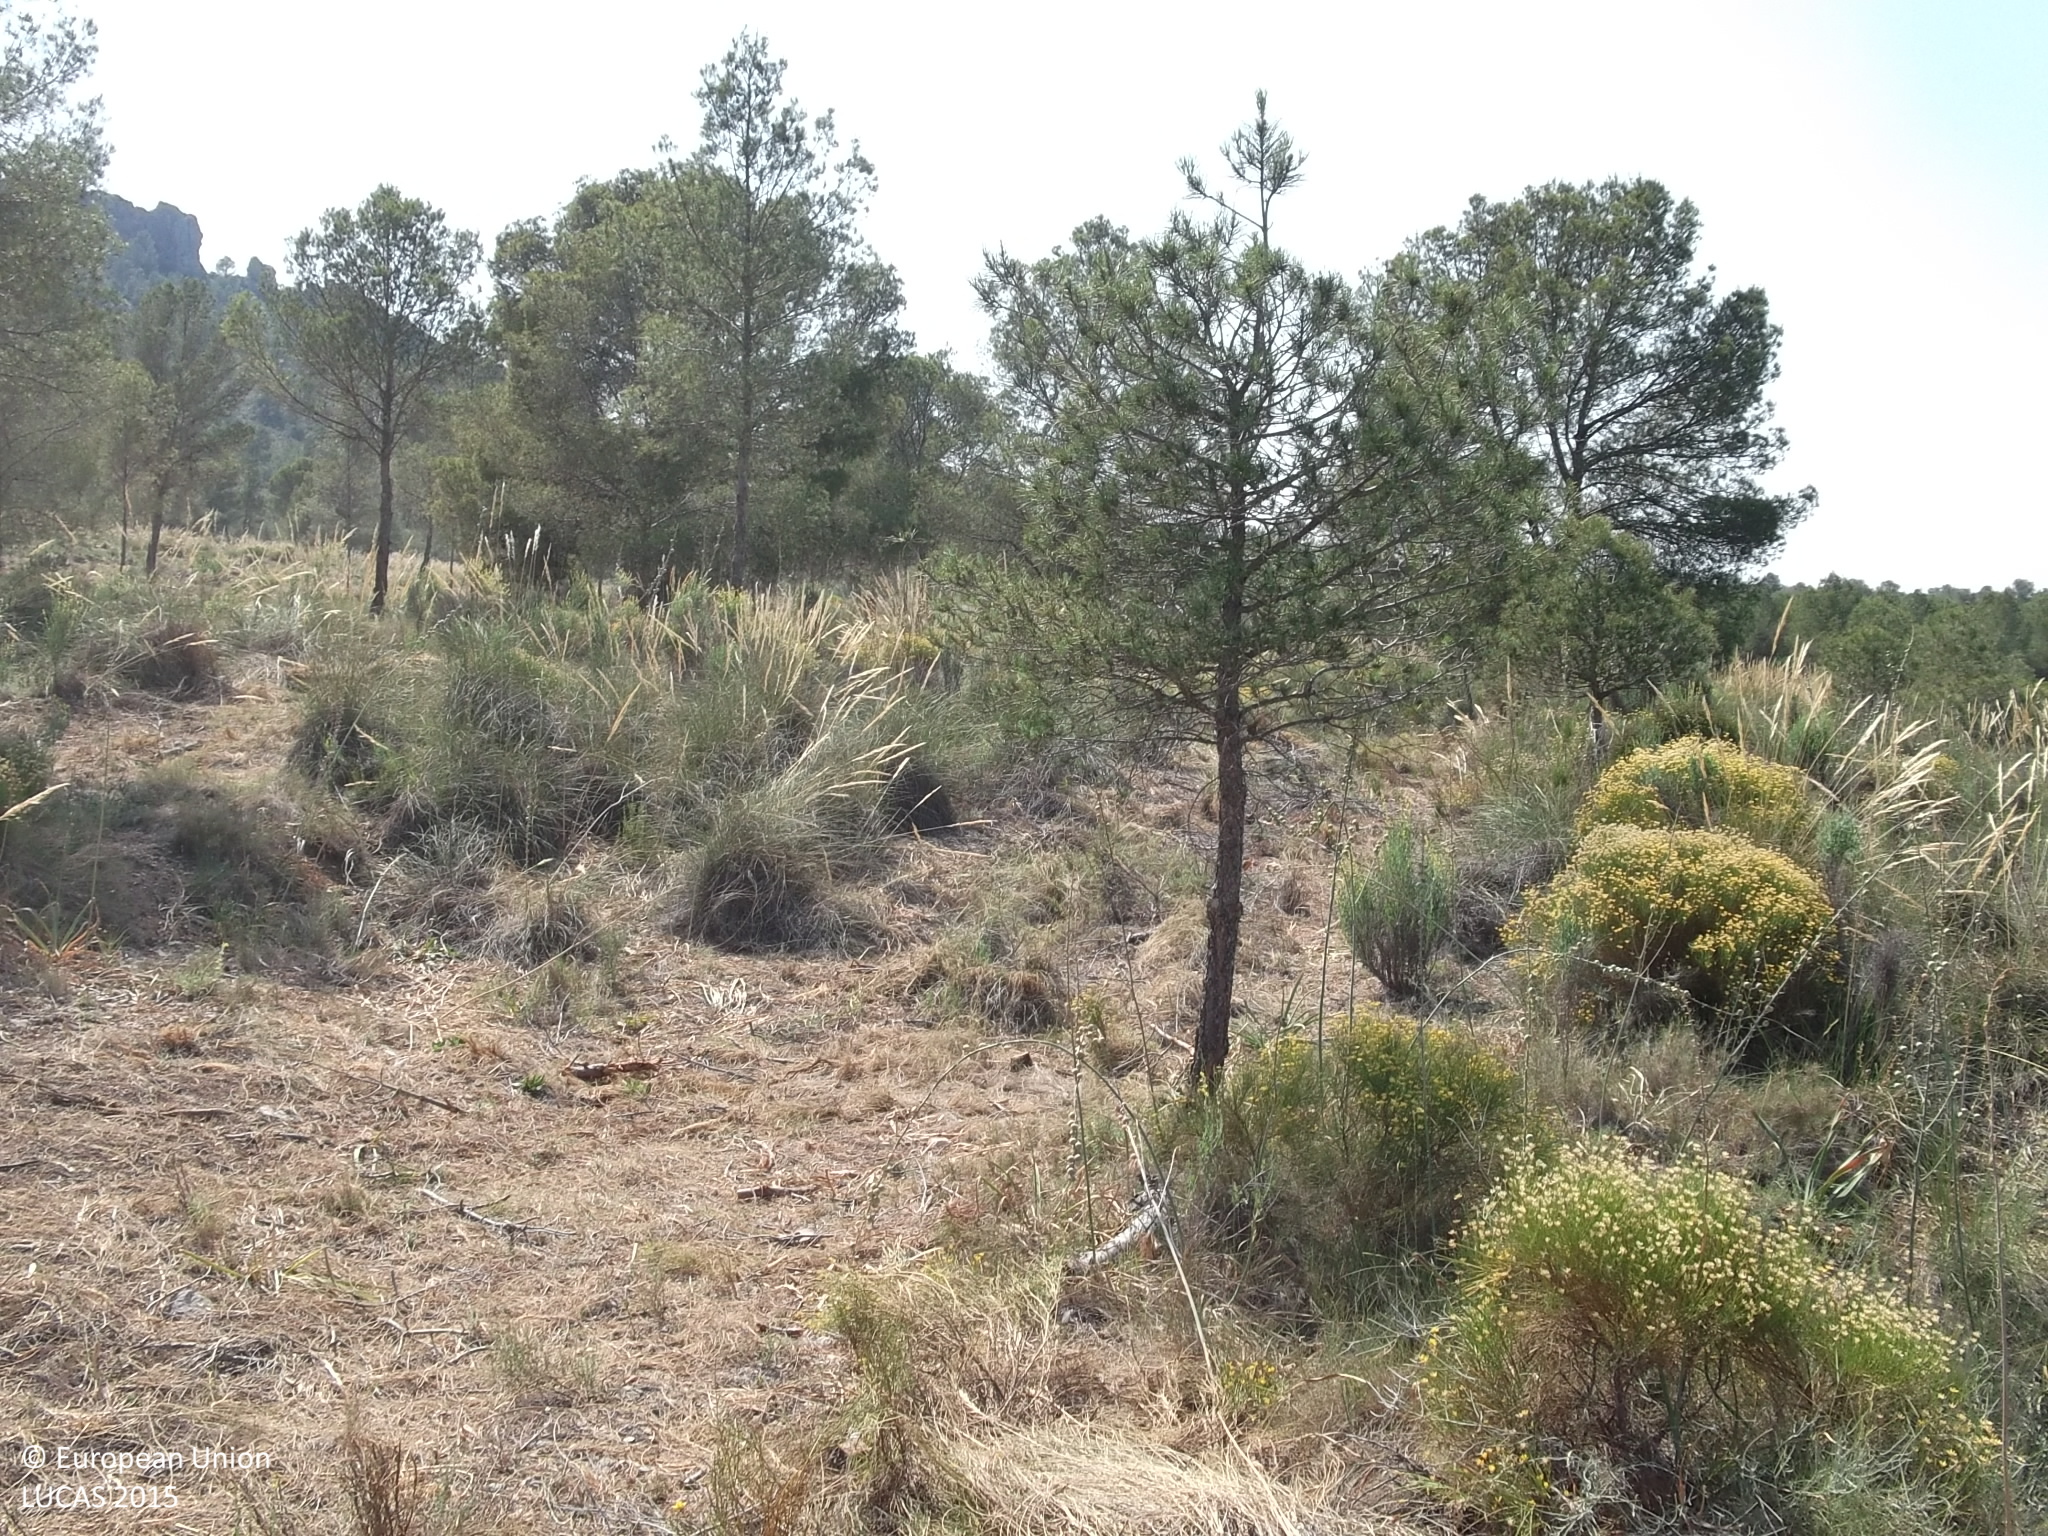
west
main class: Woodland
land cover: Pine dominated coniferous woodland
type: coniferous forest of the mediterranean region
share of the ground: 10 - 25 %
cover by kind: shrubs 30 %, herbaceous plants 30 %, coniferous forest trees 20 %, consolidated bare surface 20 %
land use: Semi-natural and natural areas not in use
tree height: < 5 m
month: May
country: ES
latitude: 38.4000
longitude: -1.6598
